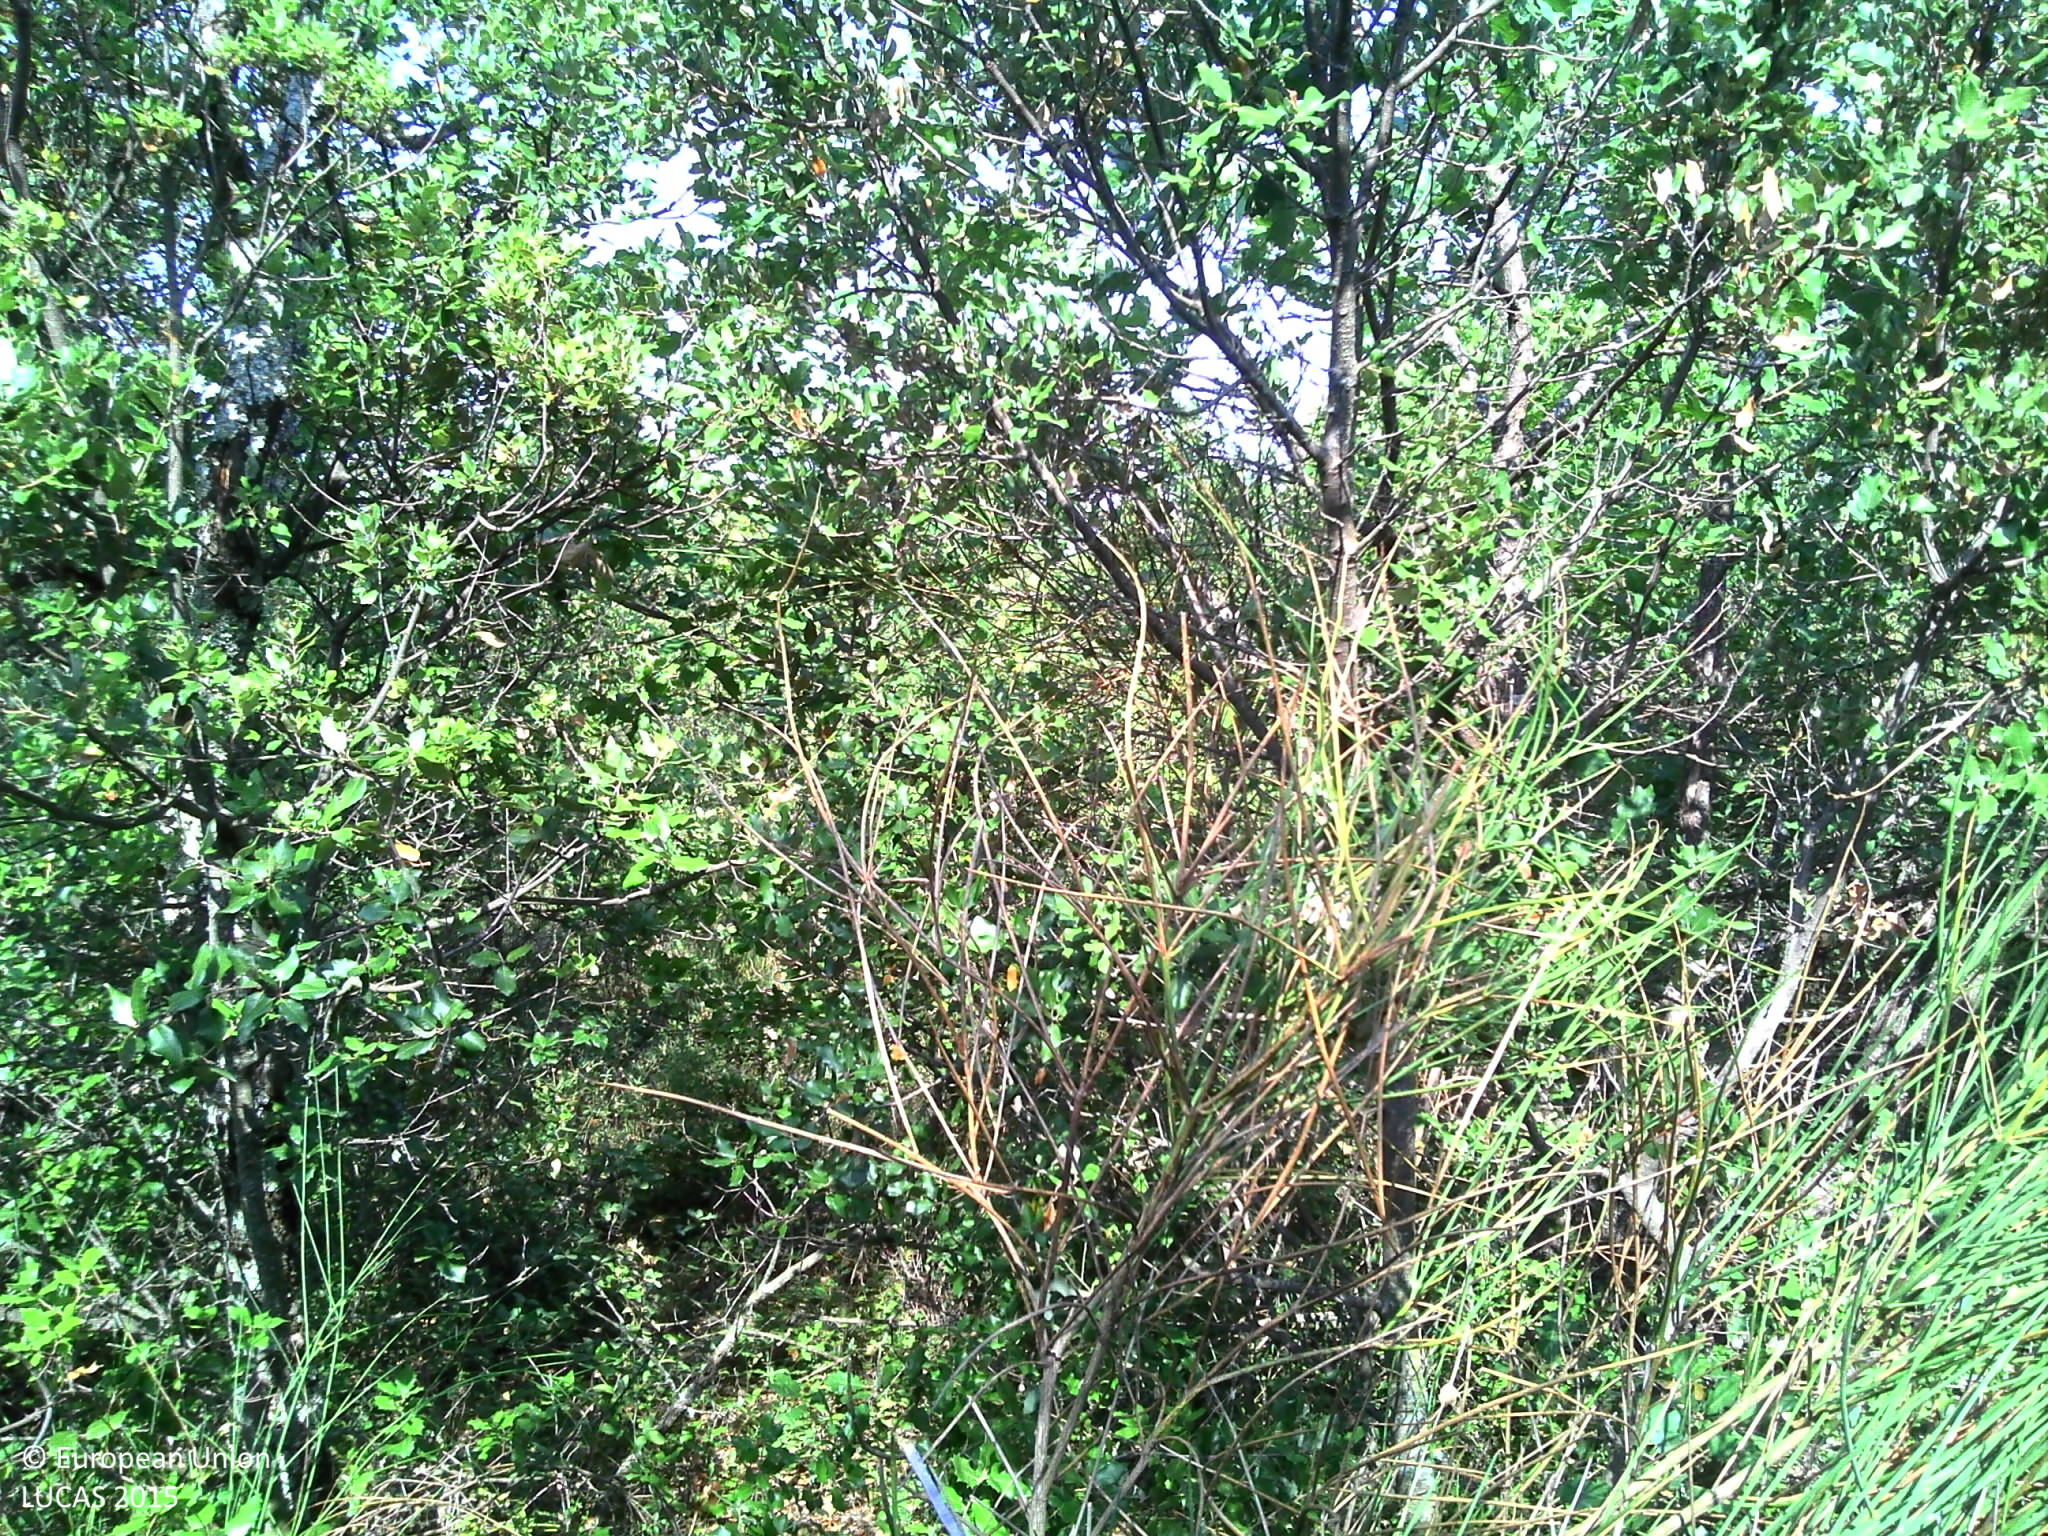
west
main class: Woodland
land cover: Broadleaved woodland
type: thermophilous deciduous forest
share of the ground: > 75 %
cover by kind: broadleaved forest trees 60 %, shrubs 20 %, herbaceous plants 10 %, lichens and mosses 5 %, unconsolidated bare surface 5 %
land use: Semi-natural and natural areas not in use
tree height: < 5 m
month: July
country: FR
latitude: 44.1141
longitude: 5.2226
